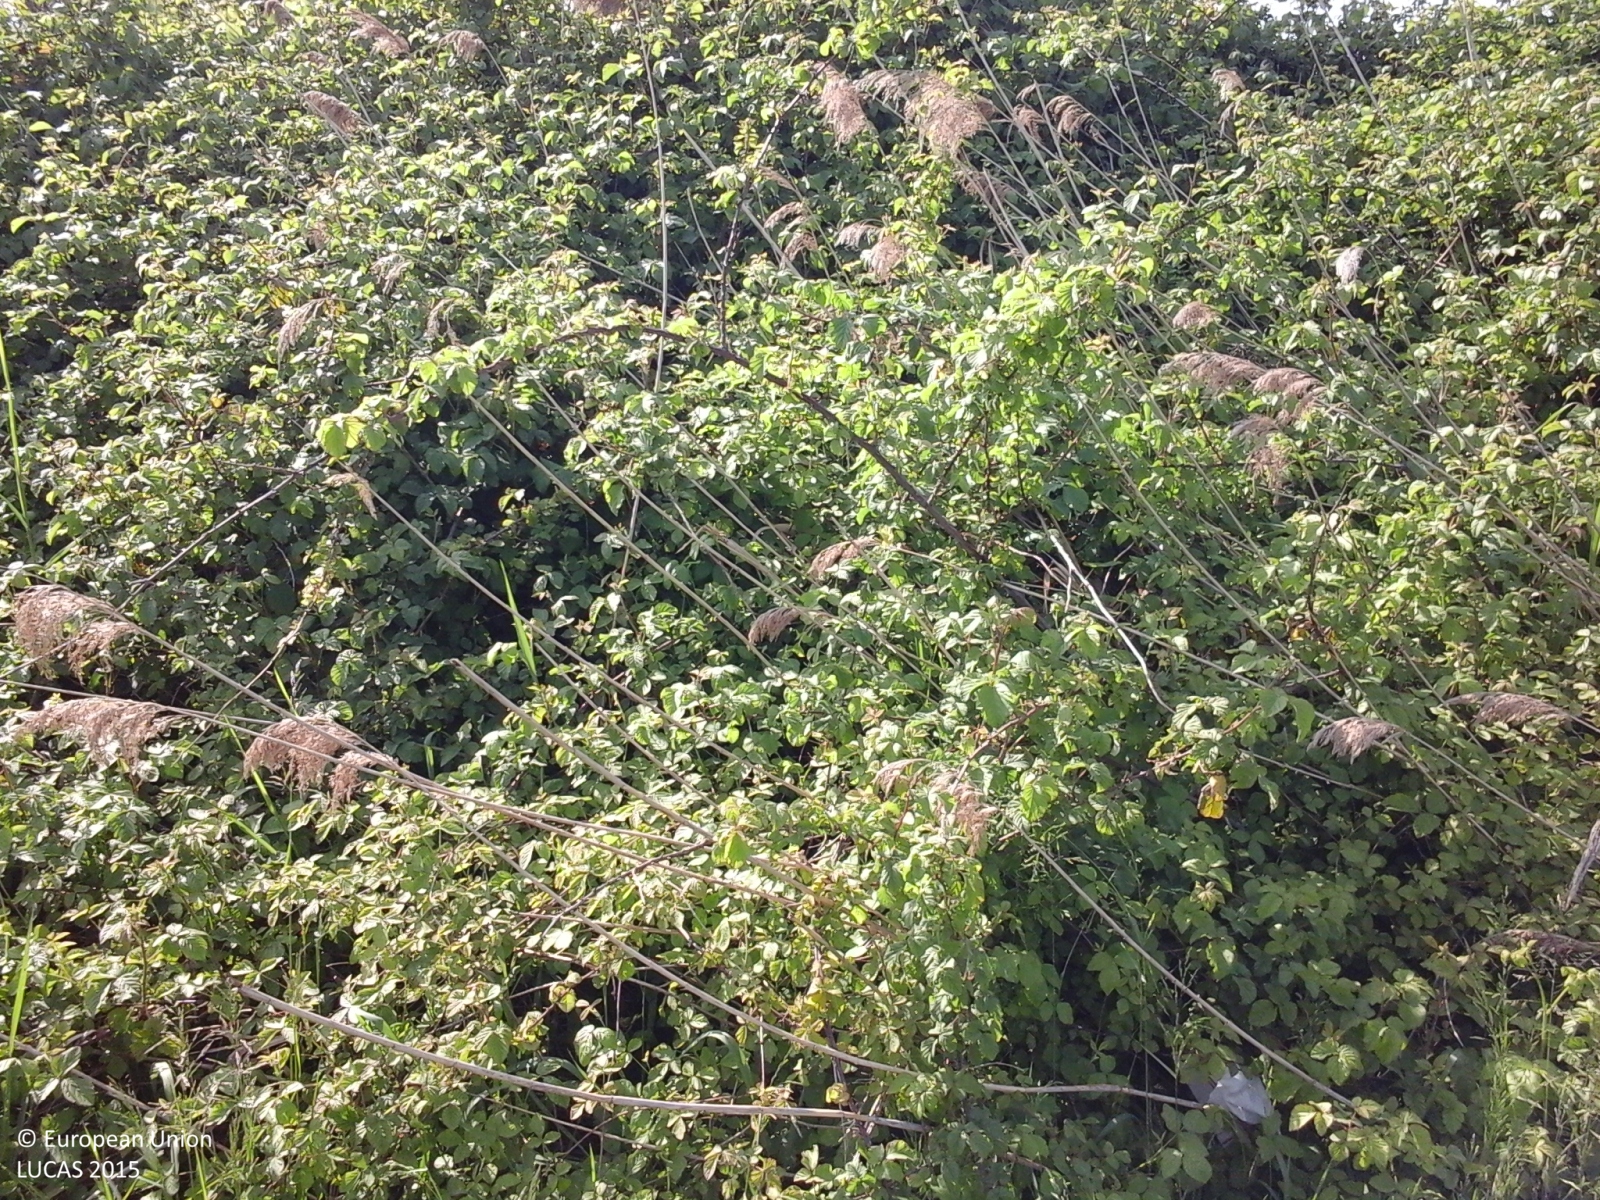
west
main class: Artificial land
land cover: Non built-up linear features
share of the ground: > 75 %
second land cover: Grassland without tree/shrub cover
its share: > 75 %
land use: Road transport
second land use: Community services
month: April
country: IT
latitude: 45.4453
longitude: 12.2083
